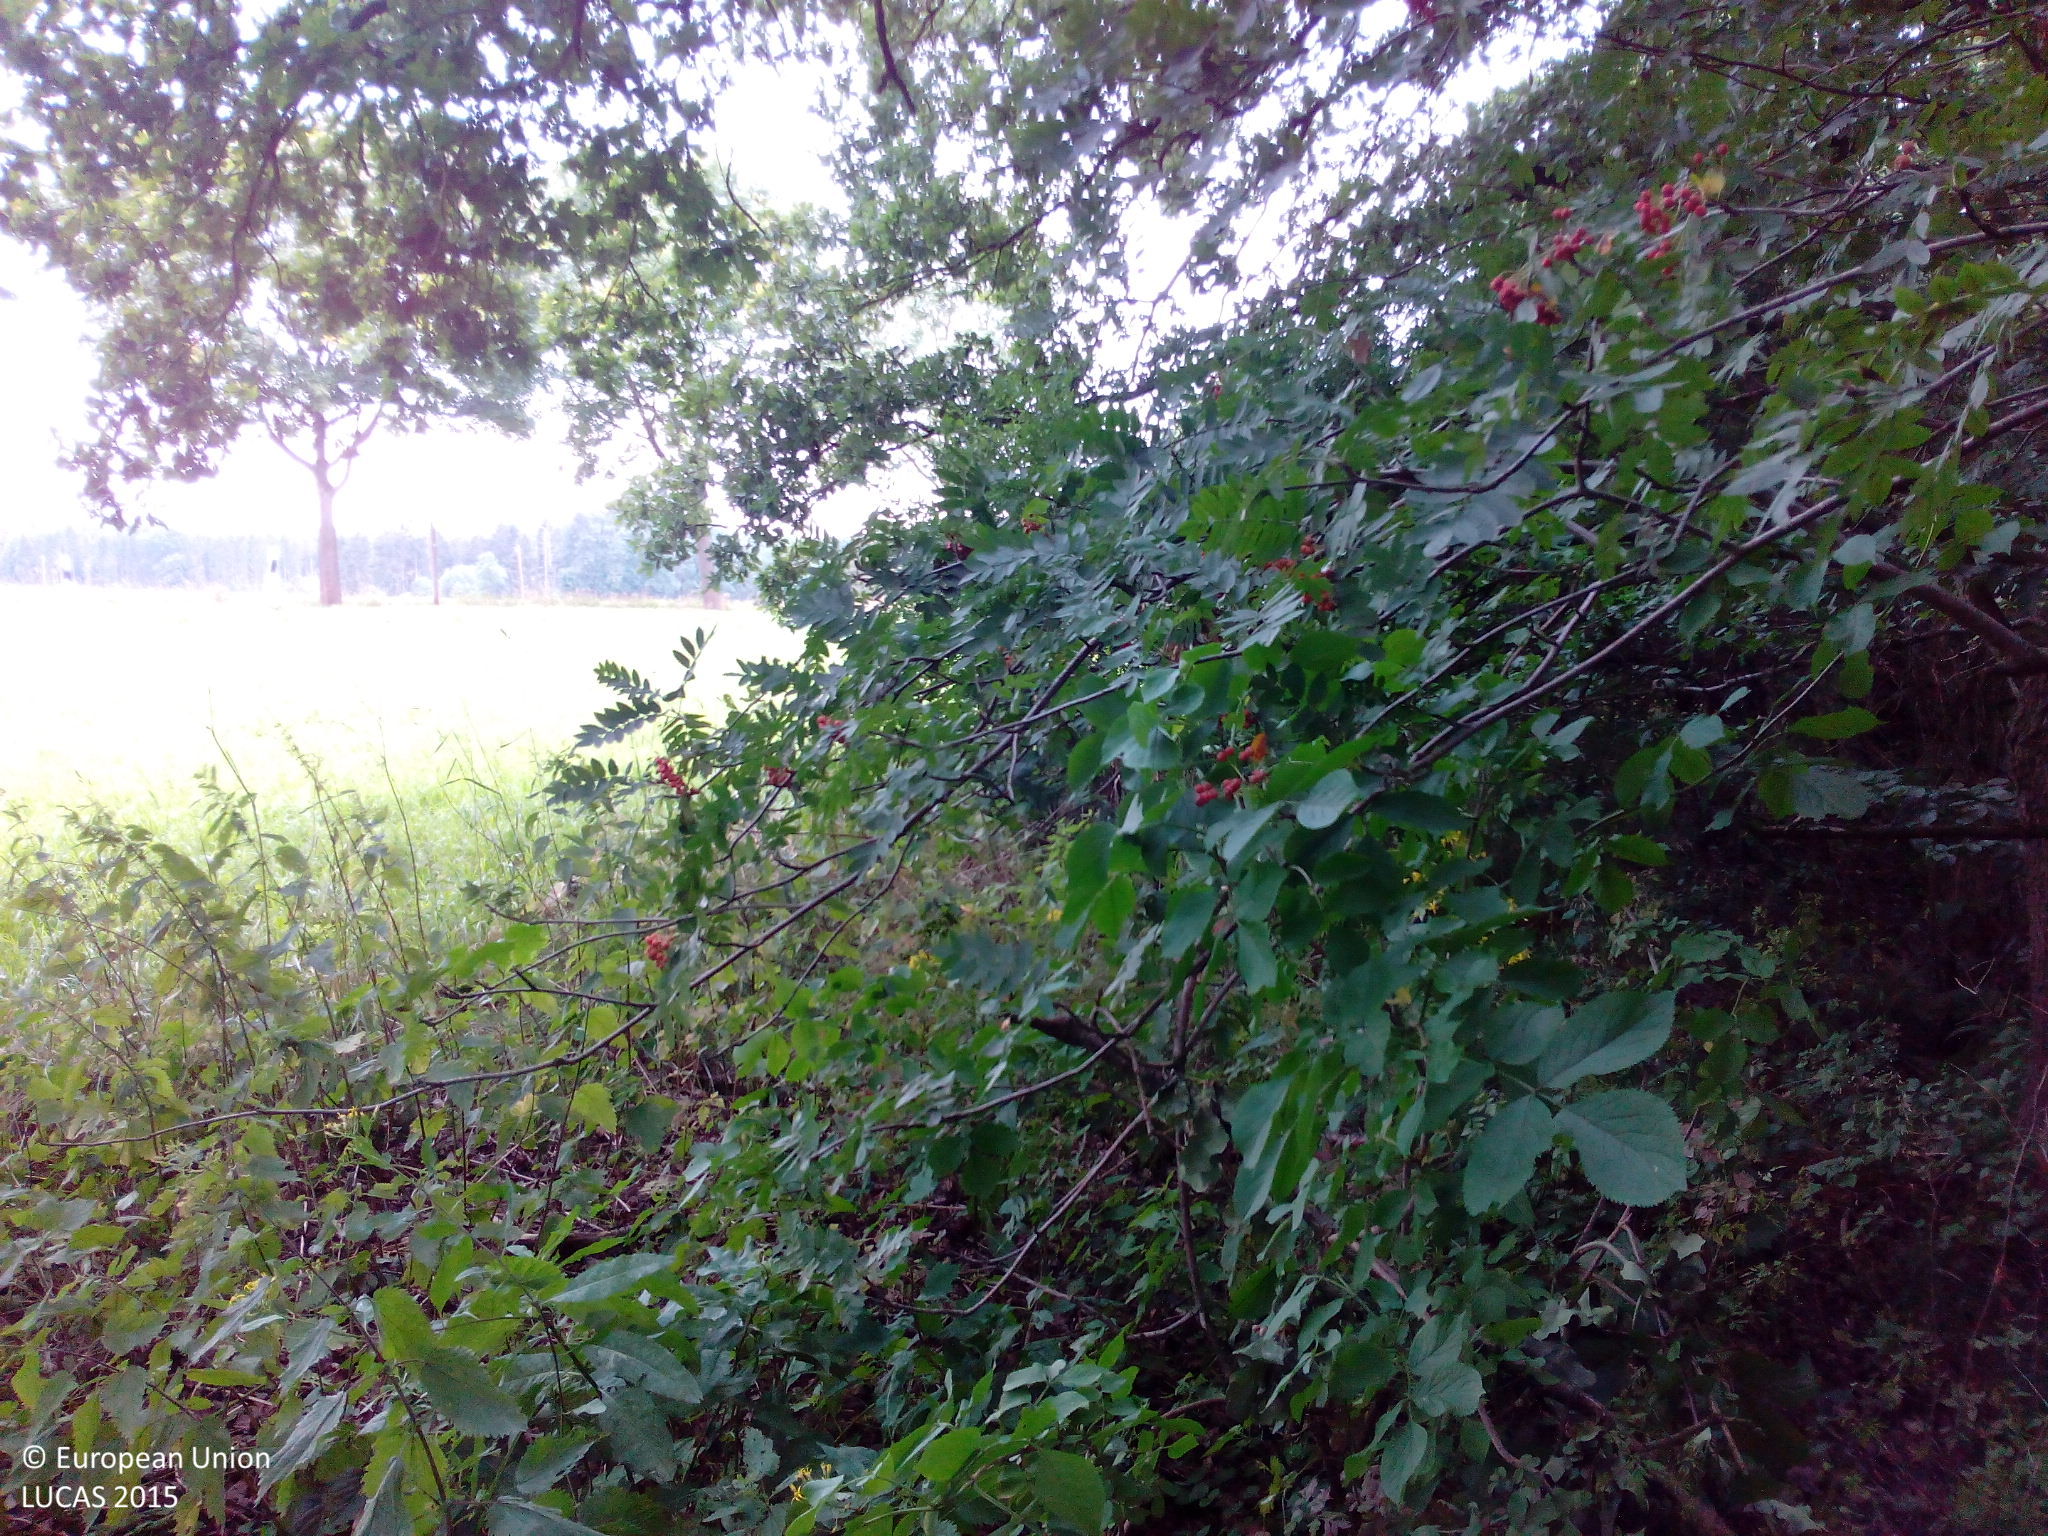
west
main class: Woodland
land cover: Broadleaved woodland
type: mesophytic deciduous forest
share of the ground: > 75 %
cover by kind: broadleaved forest trees 100 %
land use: Forestry
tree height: > 5 m
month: July
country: DE
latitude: 51.6024
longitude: 9.2928
